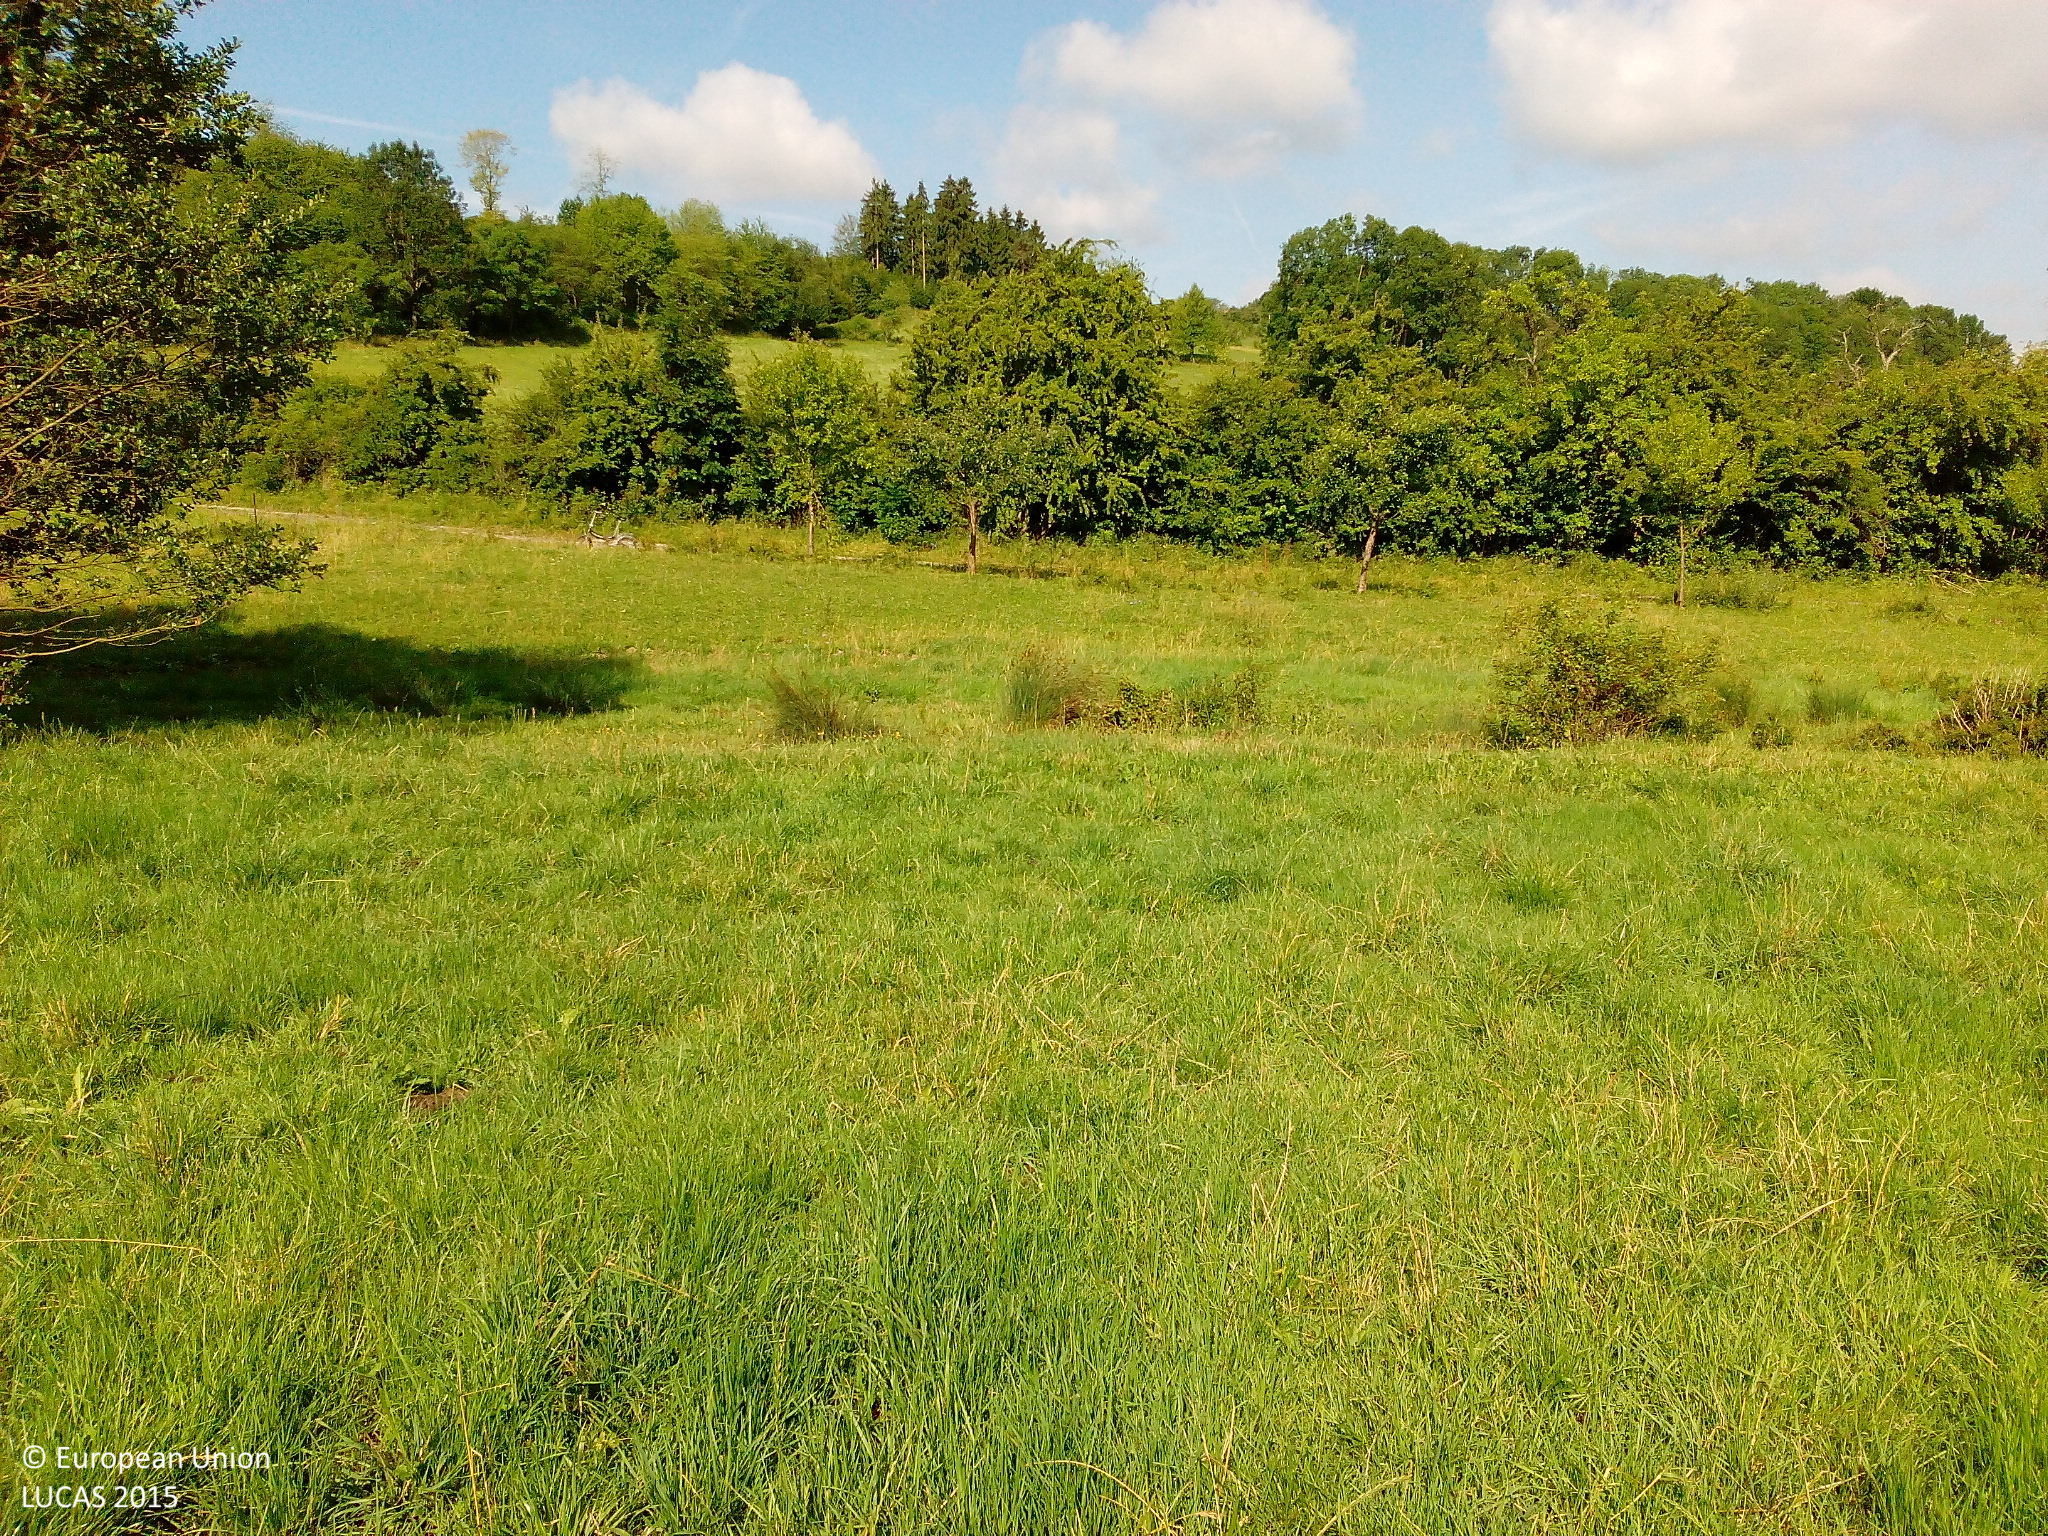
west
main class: Grassland
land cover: Grassland without tree/shrub cover
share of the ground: > 75 %
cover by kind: herbaceous plants 100 %
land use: Agriculture (excluding fallow land and kitchen gardens)
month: July
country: DE
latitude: 50.6517
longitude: 9.9010
